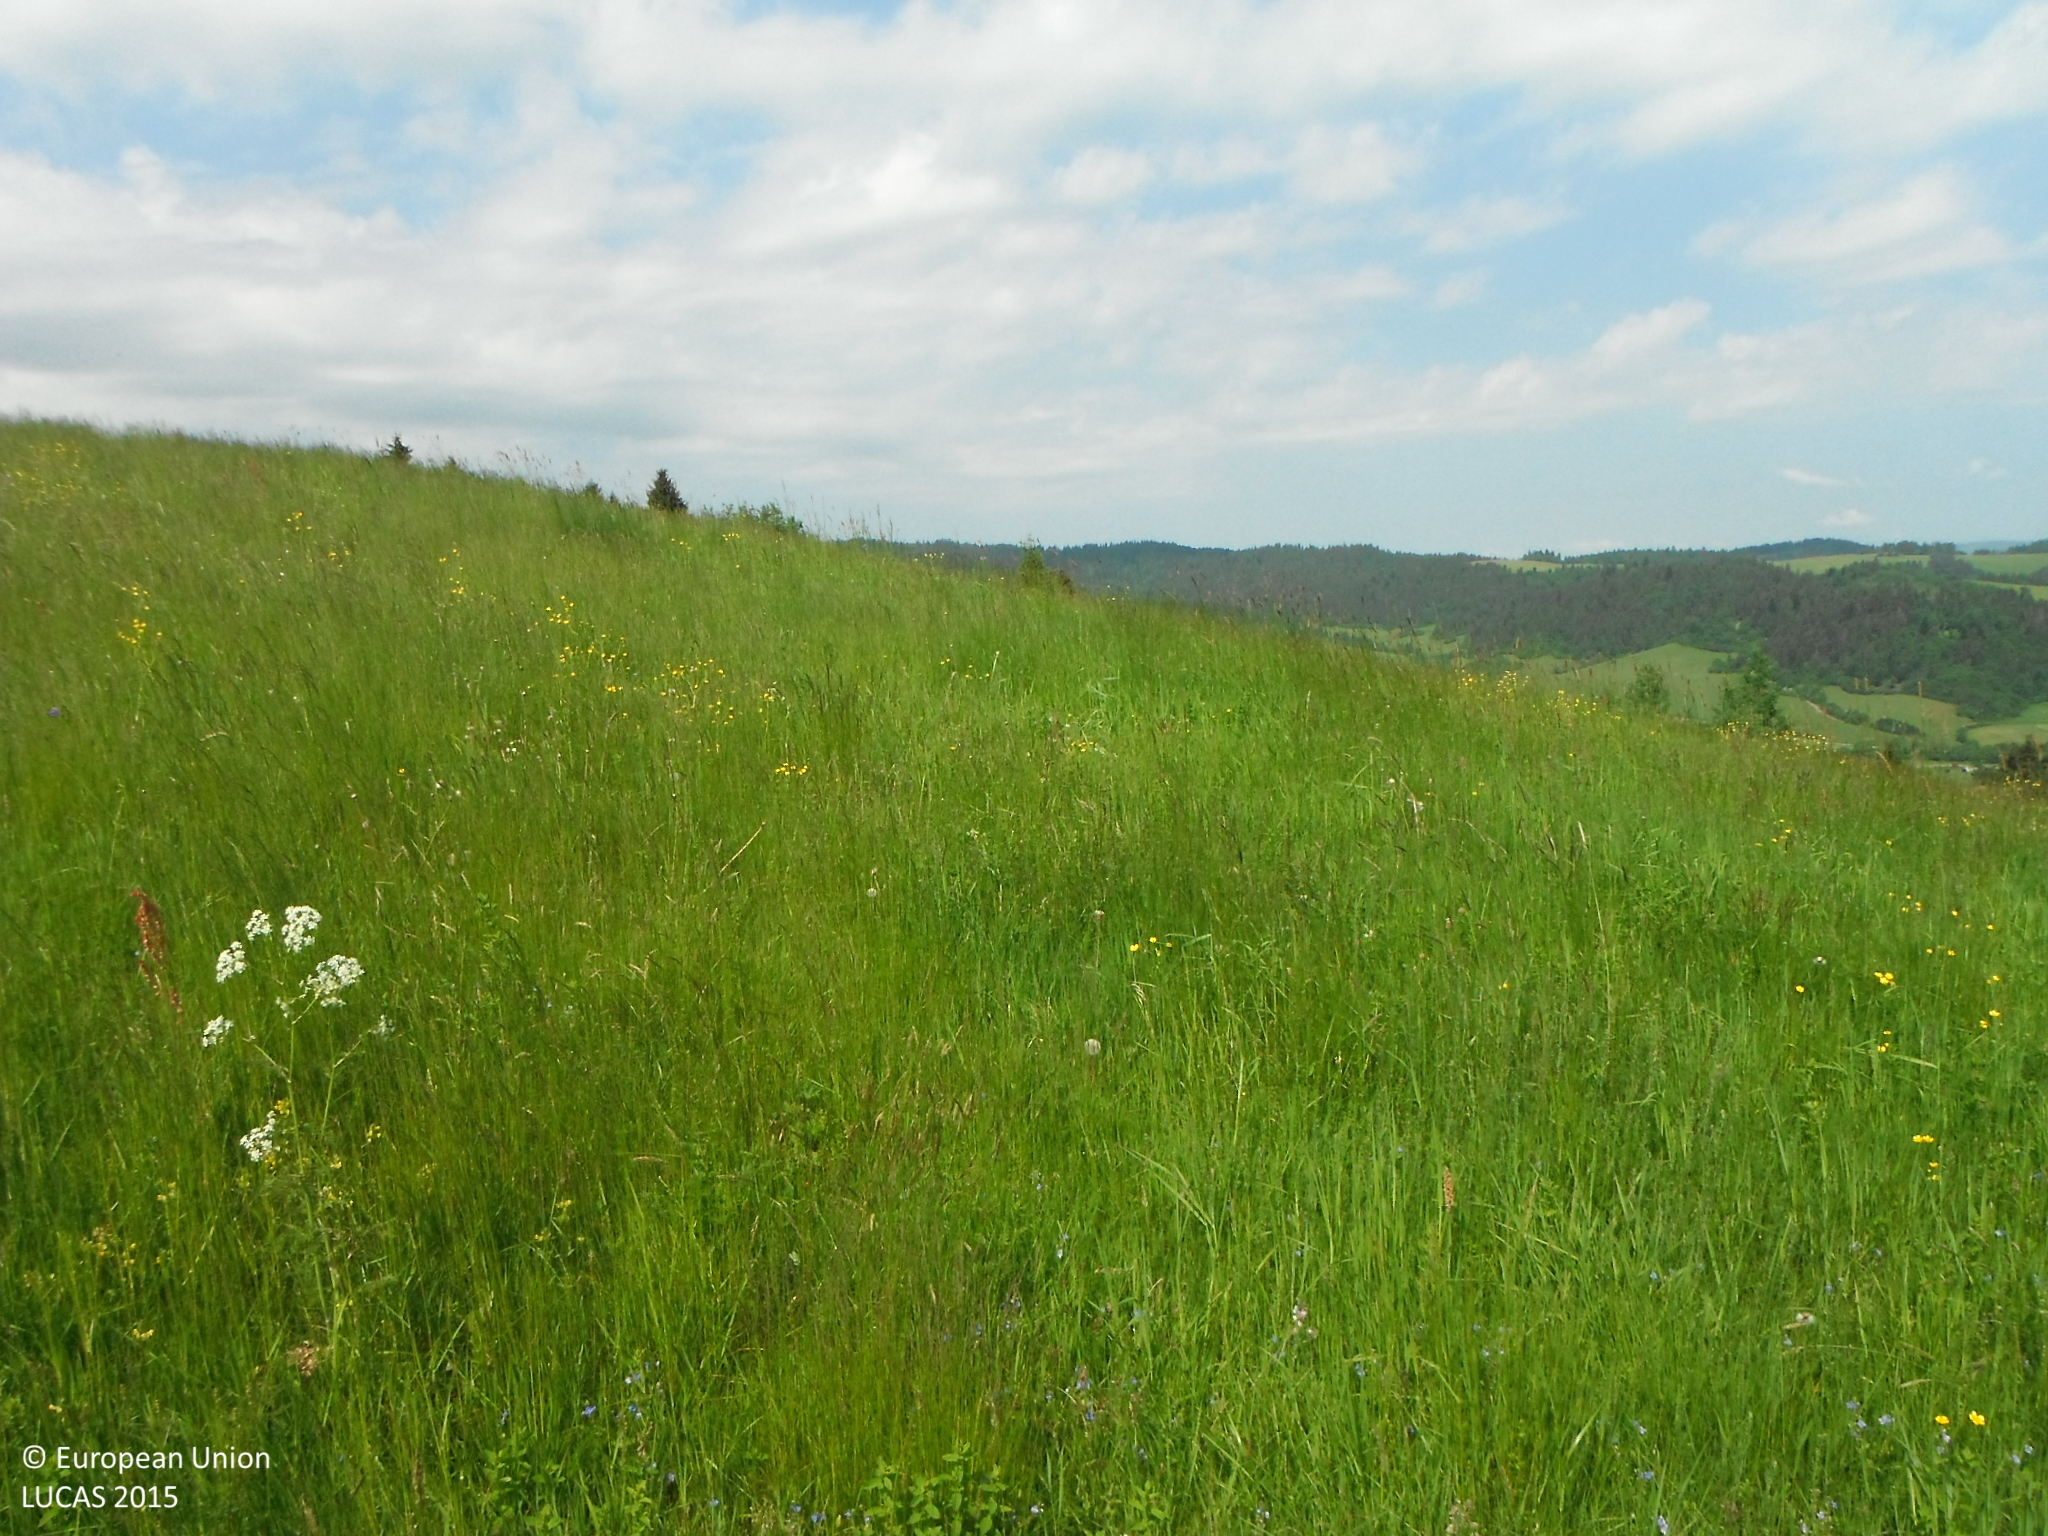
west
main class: Grassland
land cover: Grassland without tree/shrub cover
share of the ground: > 75 %
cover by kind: herbaceous plants 100 %
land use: Agriculture (excluding fallow land and kitchen gardens)
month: June
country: SK
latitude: 49.3471
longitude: 20.3728
